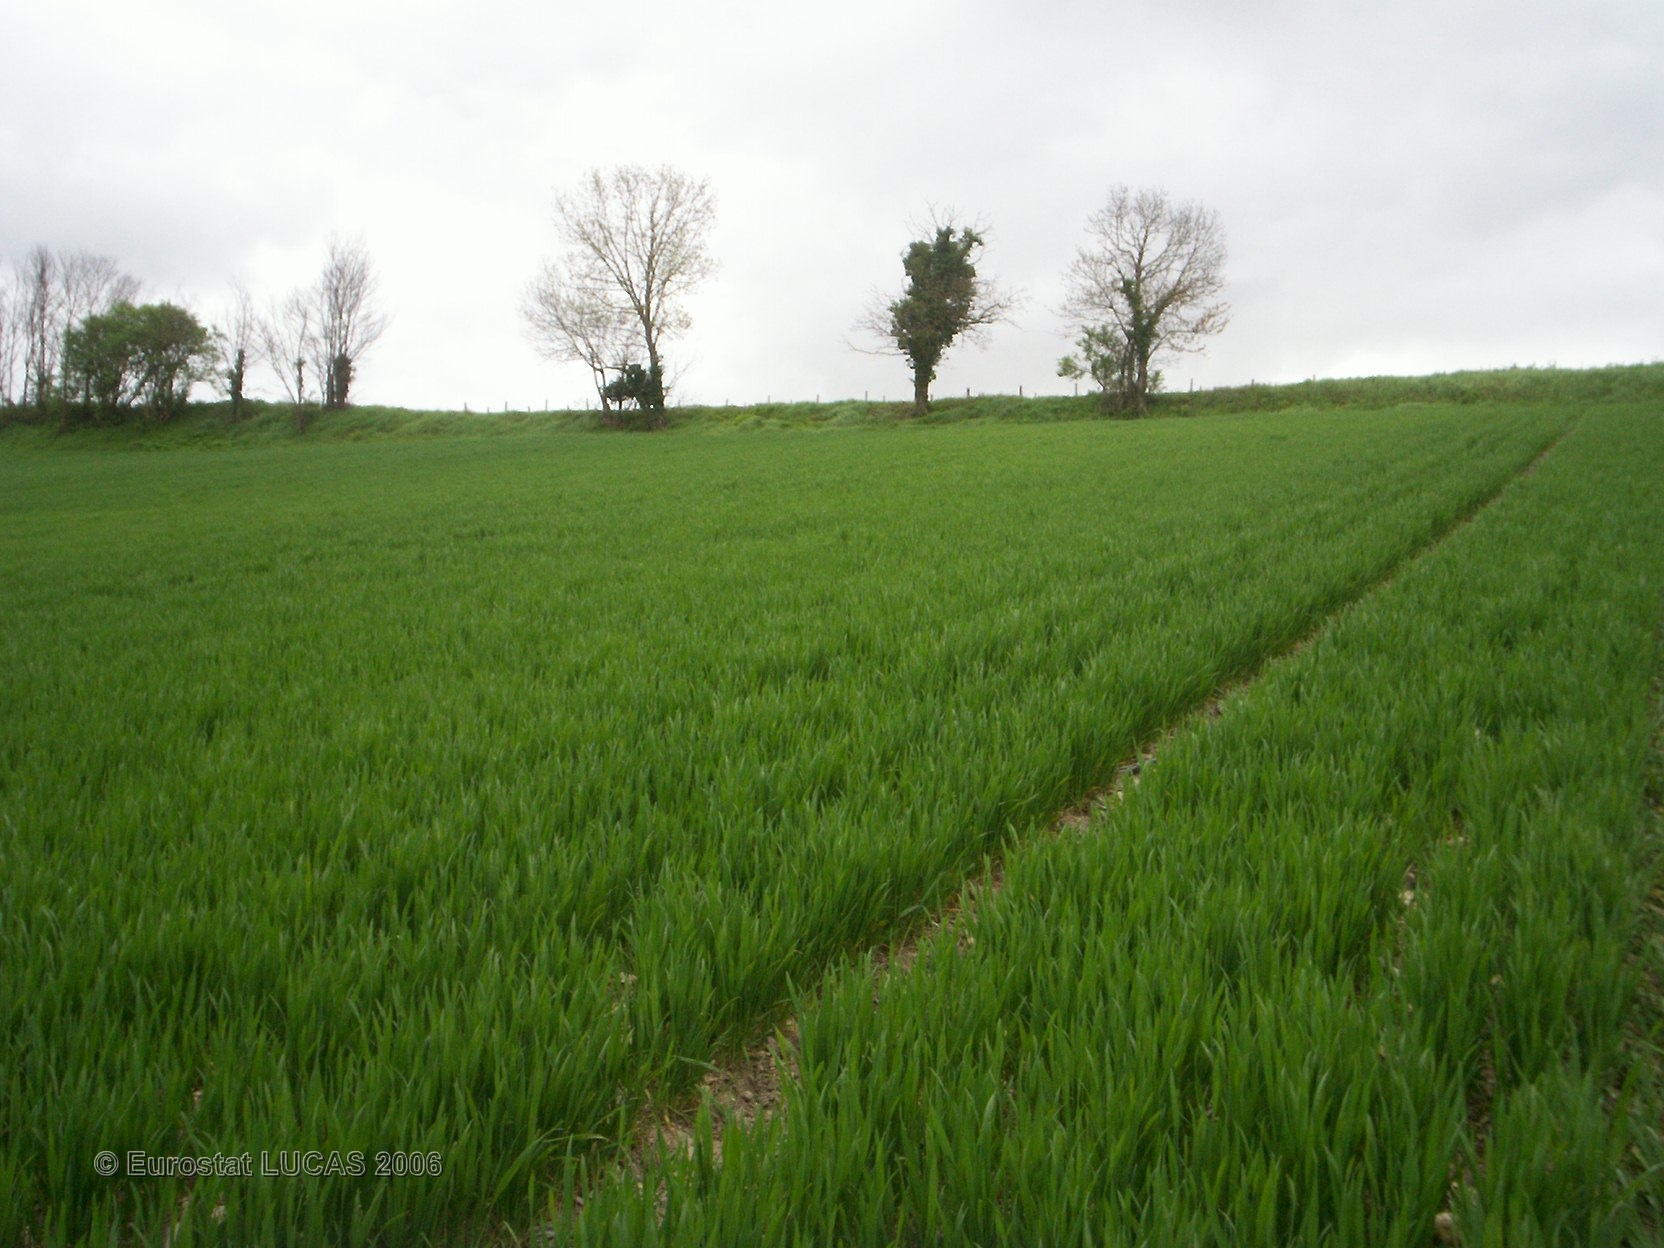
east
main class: Cropland
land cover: Durum wheat
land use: Agriculture (excluding fallow land and kitchen gardens)
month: April
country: FR
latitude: 45.4114
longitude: -0.7181
